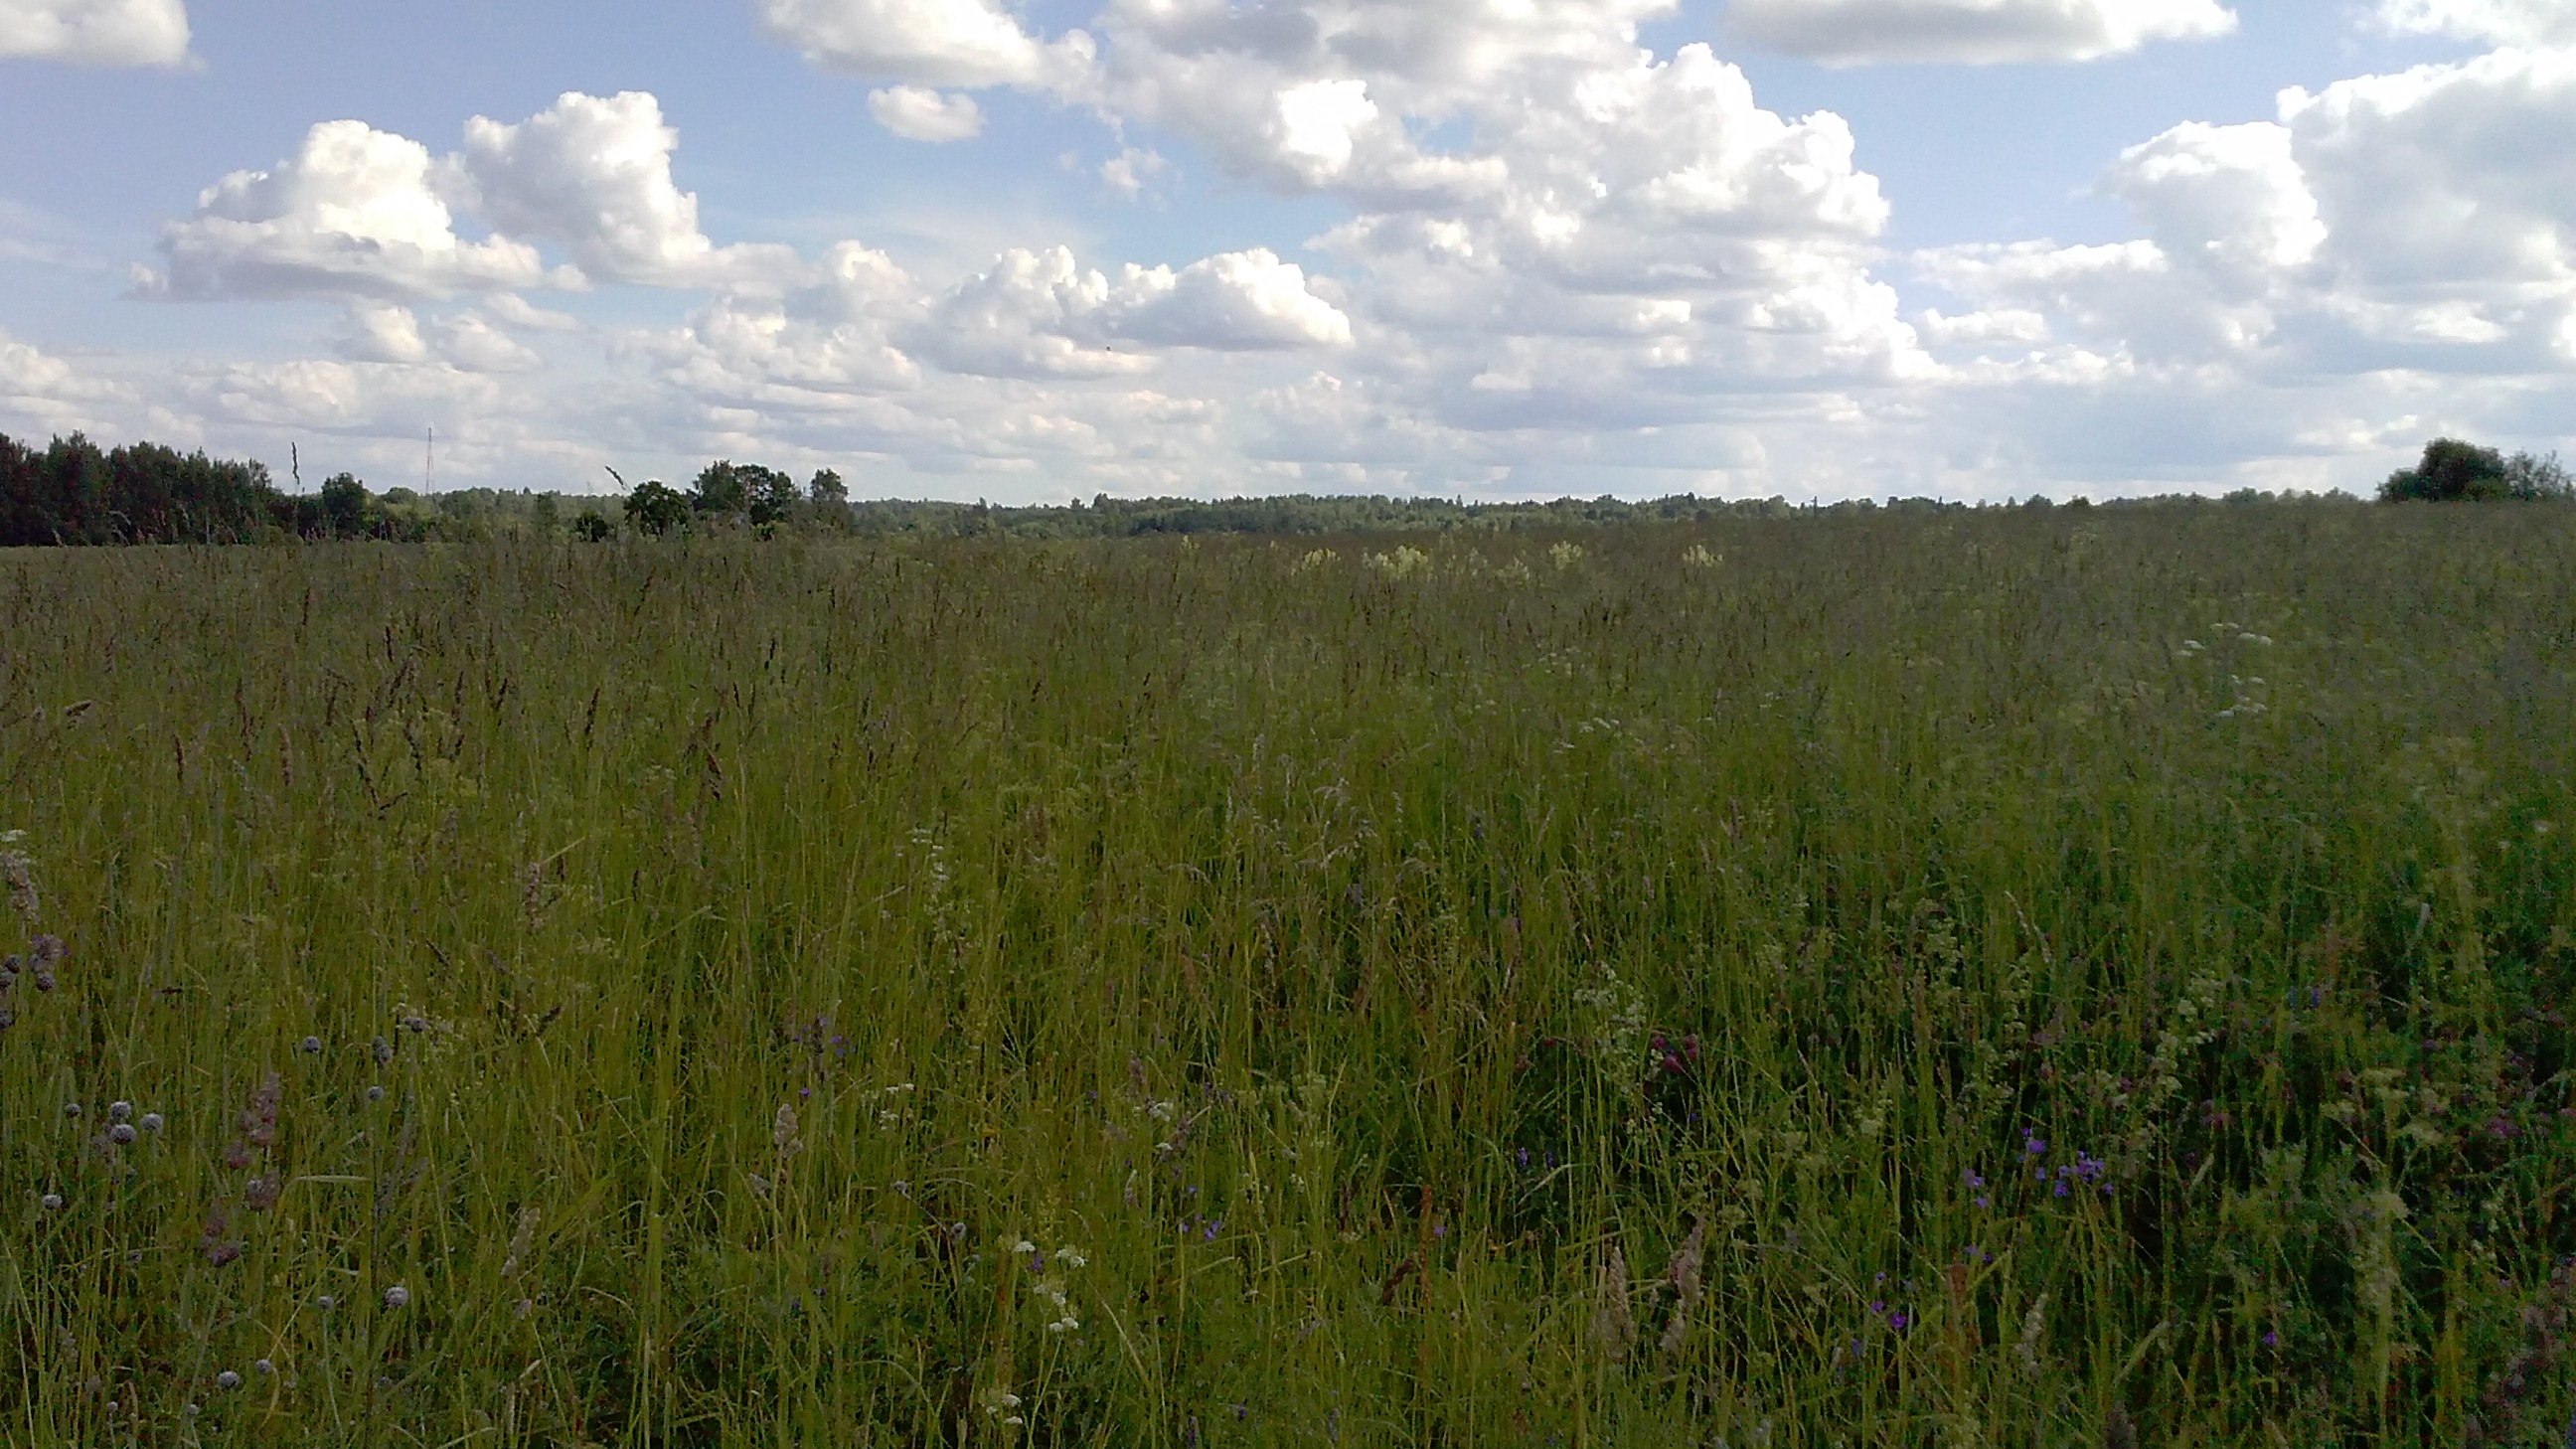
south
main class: Grassland
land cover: Grassland without tree/shrub cover
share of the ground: > 75 %
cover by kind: herbaceous plants 100 %
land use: Agriculture (excluding fallow land and kitchen gardens)
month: June
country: LV
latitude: 56.5389
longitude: 27.9022
